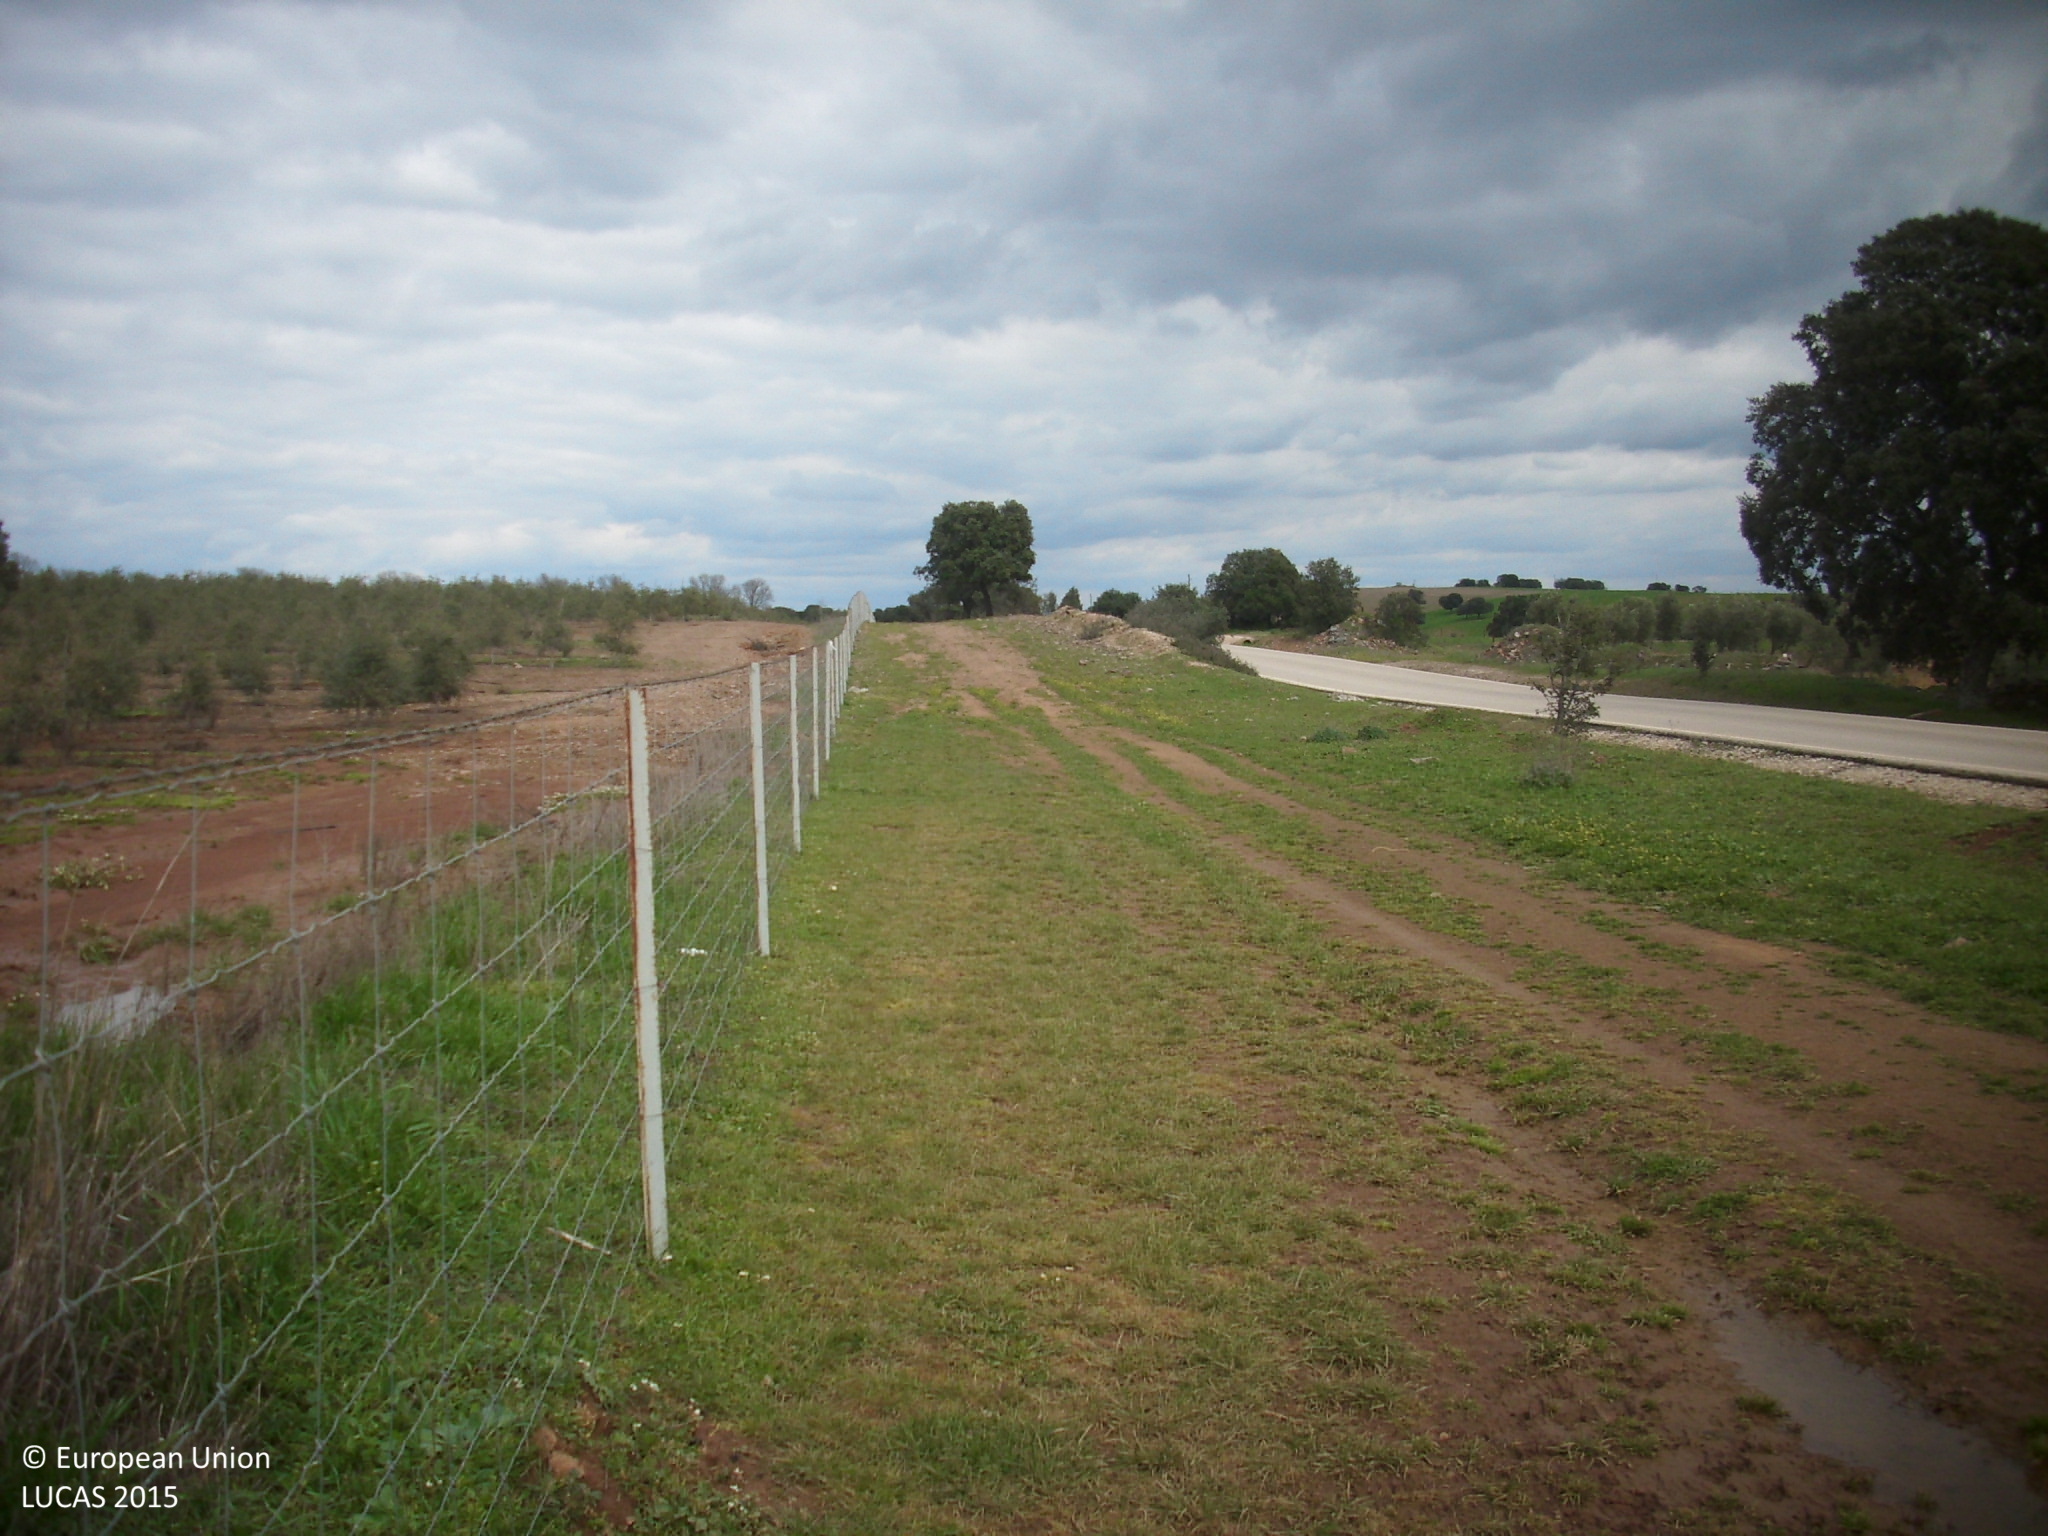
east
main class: Cropland
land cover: Olive groves
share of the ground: 50 - 75 %
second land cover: Other bare soil
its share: > 75 %
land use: Agriculture (excluding fallow land and kitchen gardens)
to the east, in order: Olive groves; Other bare soil; Single bushes/trees; Olive groves
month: March
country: ES
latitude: 38.3645
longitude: -3.0608
